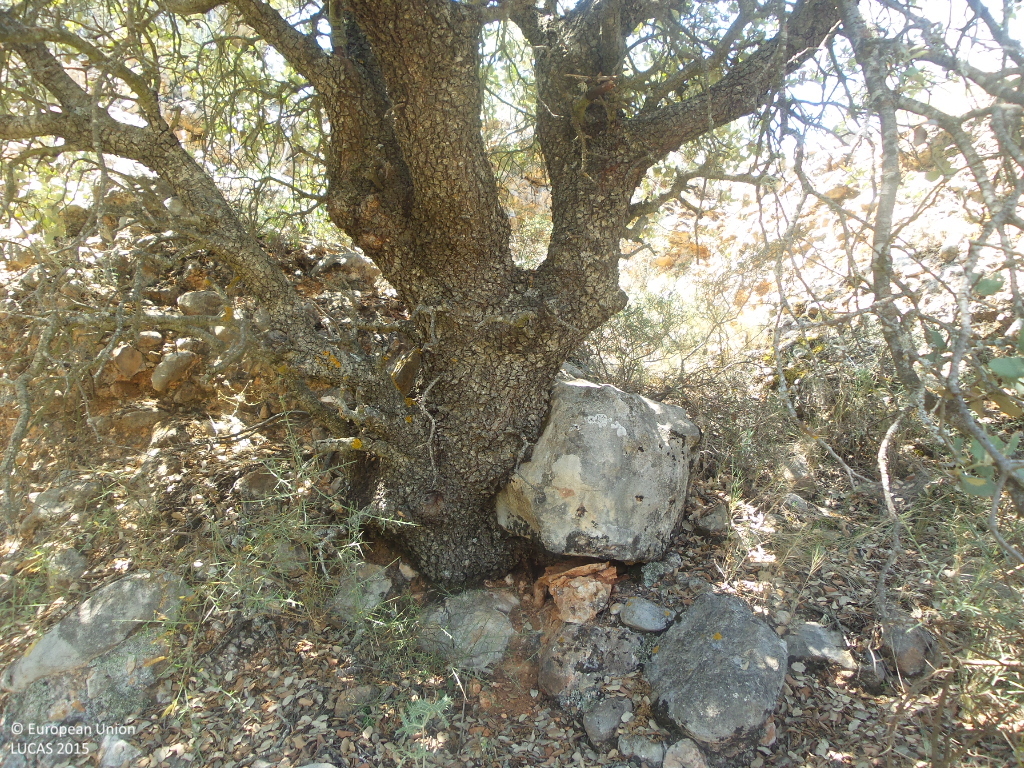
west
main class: Woodland
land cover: Other mixed woodland
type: broadleaved evergreen forest
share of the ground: 50 - 75 %
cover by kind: broadleaved forest trees 40 %, coniferous forest trees 20 %, shrubs 15 %, unconsolidated bare surface 15 %, herbaceous plants 5 %, consolidated bare surface 5 %
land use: Semi-natural and natural areas not in use
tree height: > 5 m
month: July
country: ES
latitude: 41.1323
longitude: -2.0223
